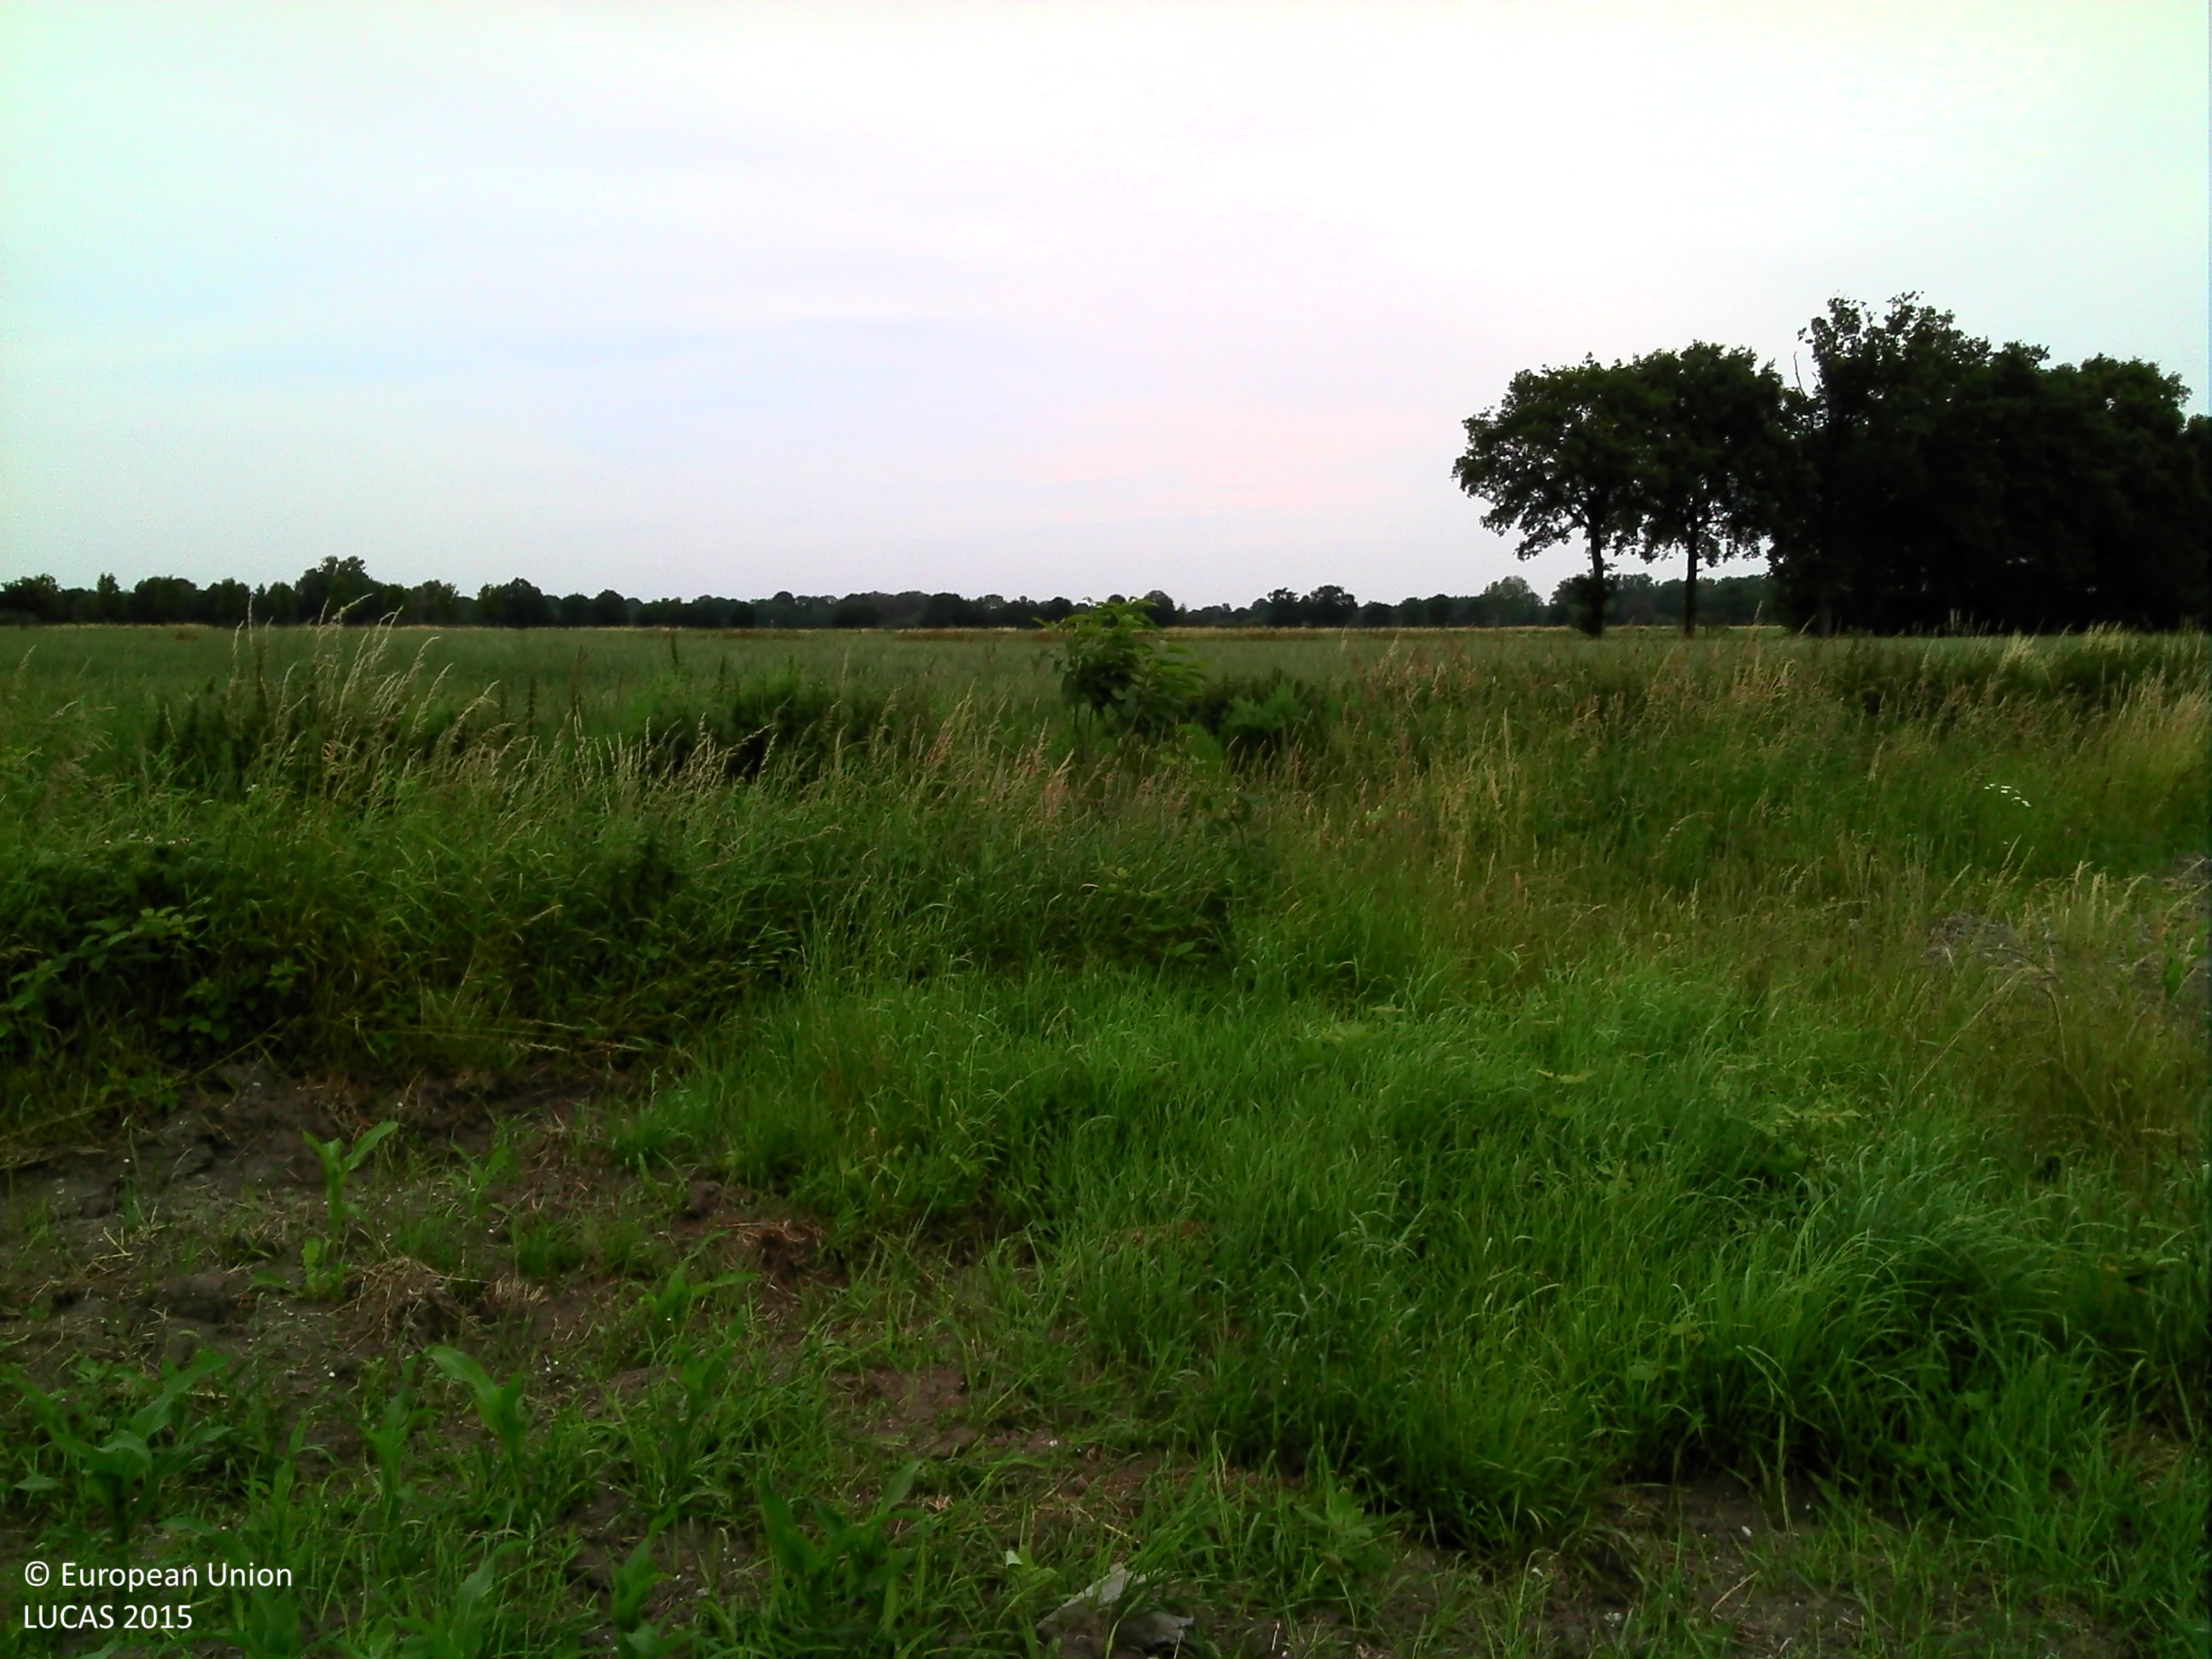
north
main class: Cropland
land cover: Maize
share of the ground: 10 - 25 %
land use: Agriculture (excluding fallow land and kitchen gardens)
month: June
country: BE
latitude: 51.1463
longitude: 5.6671
